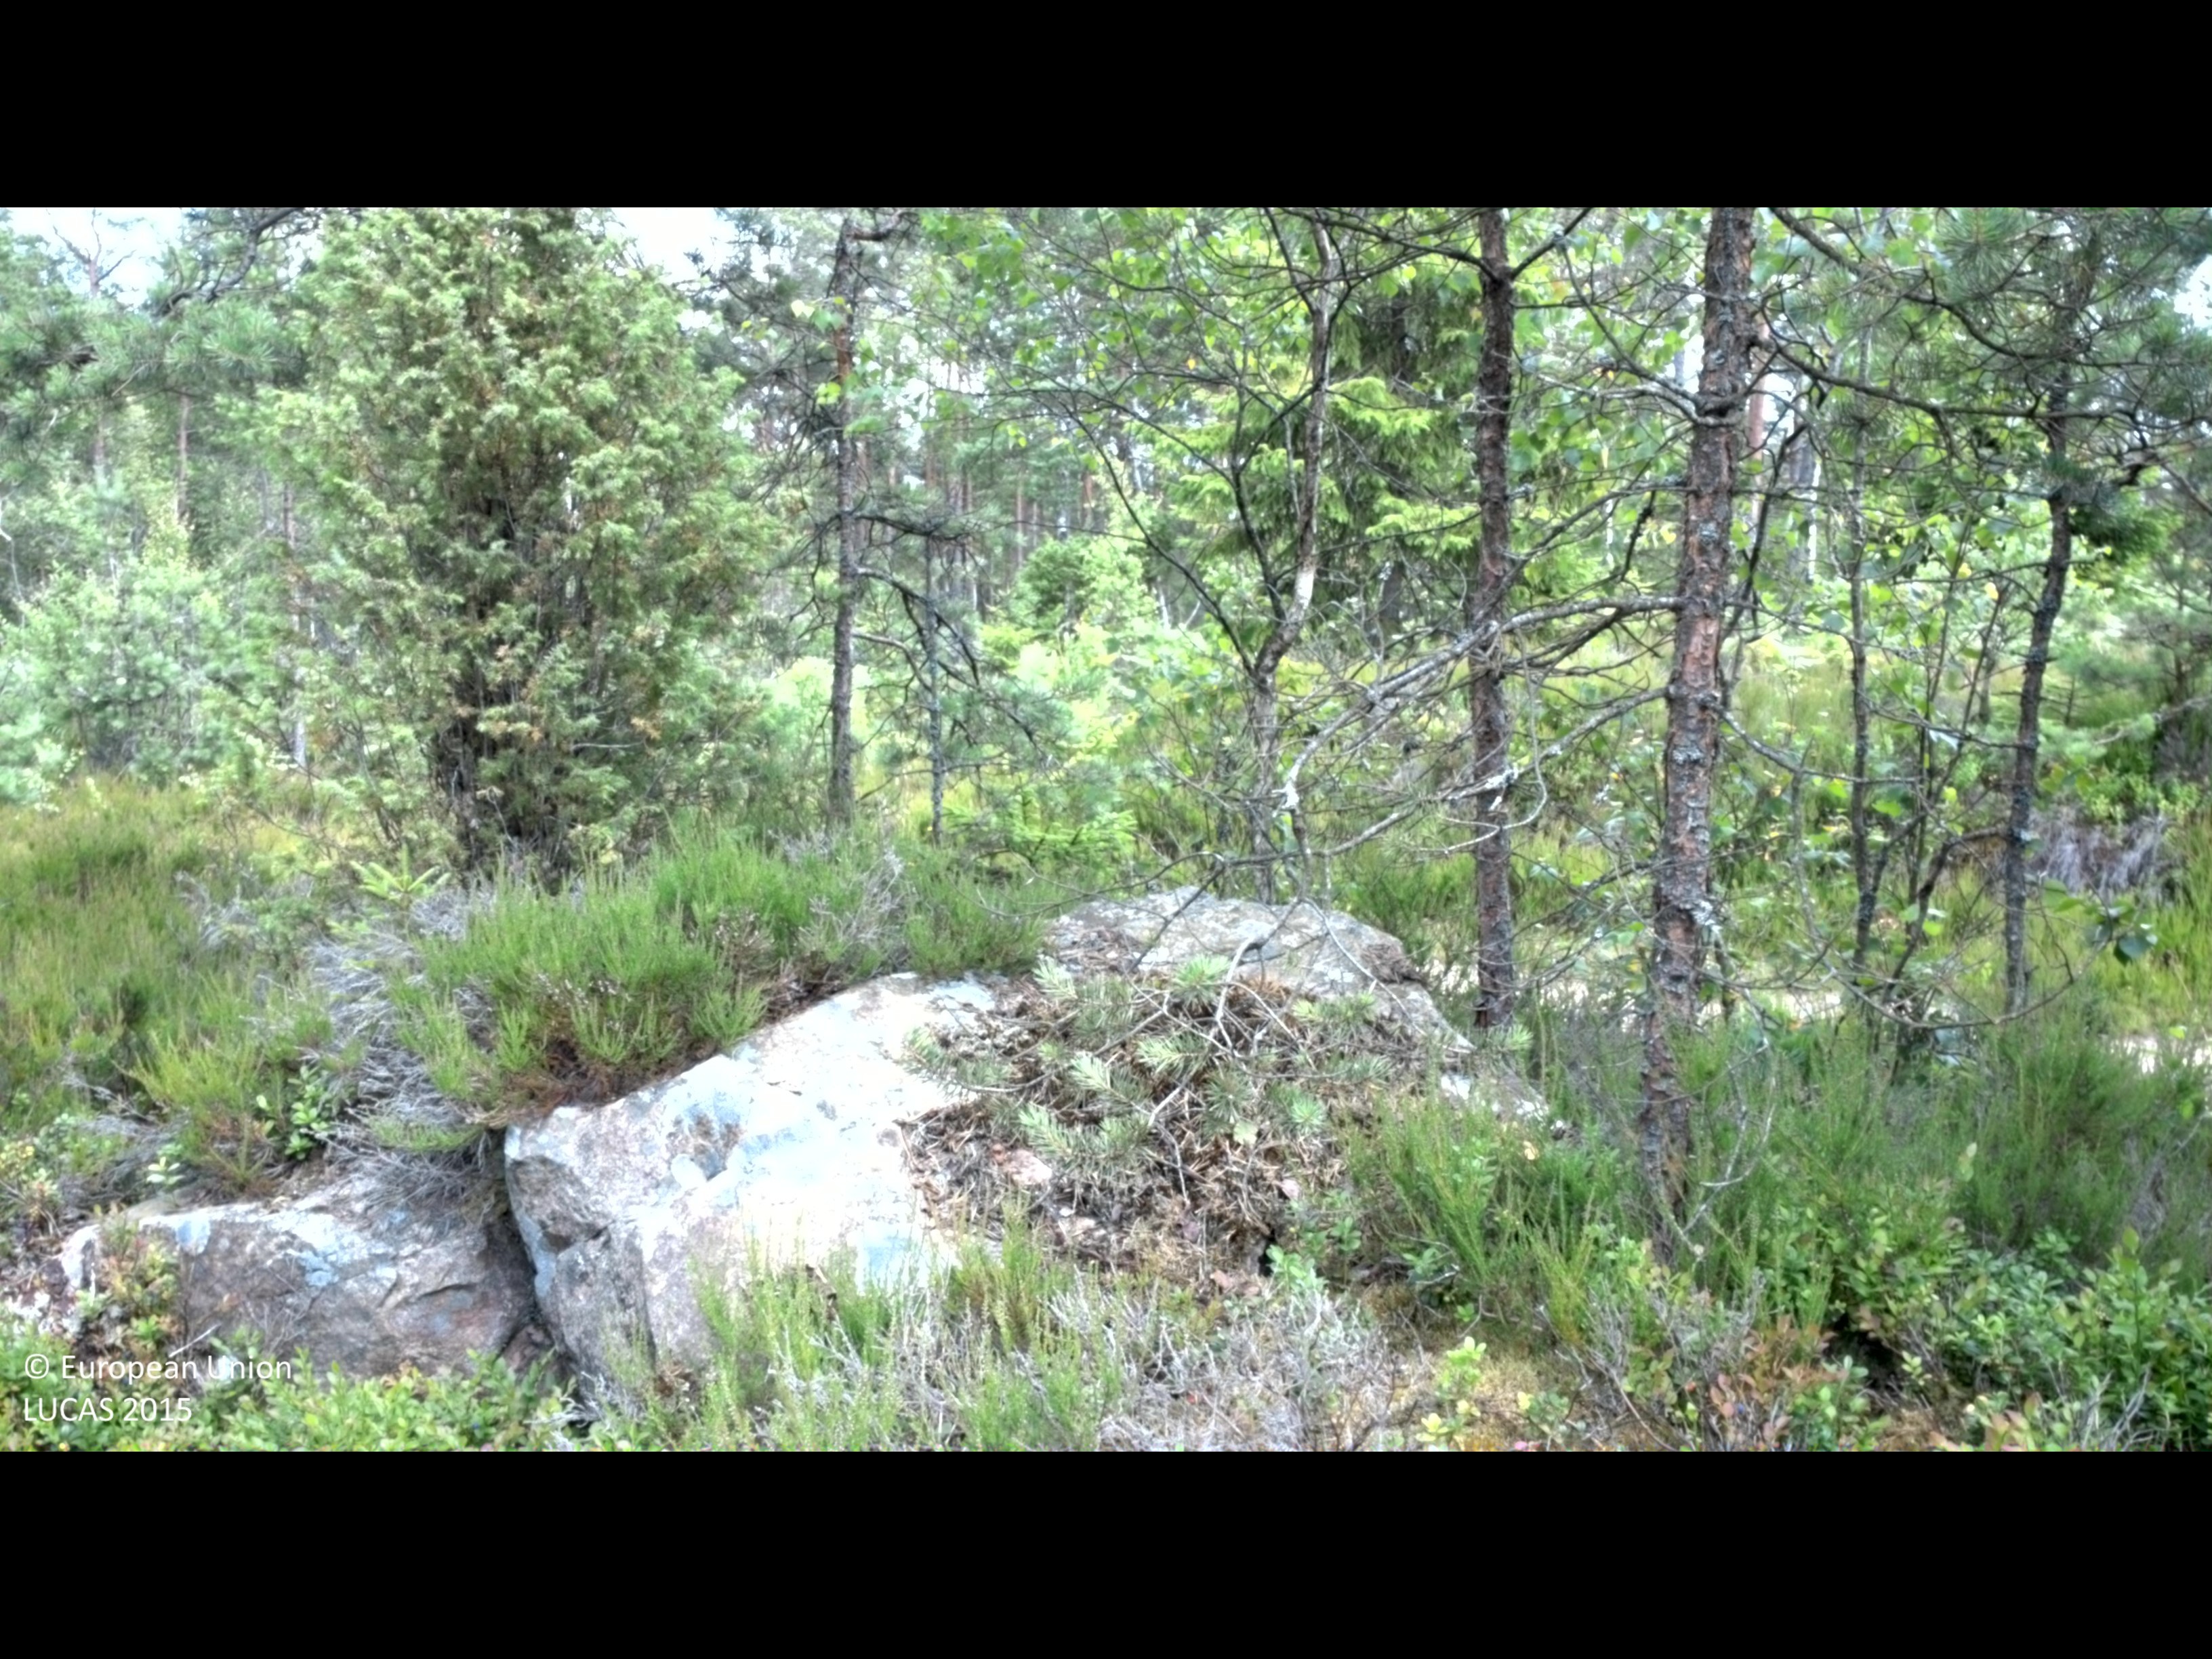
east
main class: Woodland
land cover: Pine dominated mixed woodland
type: boreal forest
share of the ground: 25 - 50 %
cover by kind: shrubs 35 %, coniferous forest trees 30 %, broadleaved forest trees 20 %, herbaceous plants 15 %
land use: Forestry
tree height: > 5 m
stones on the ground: 25 - 50 %
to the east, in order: Pine dominated mixed woodland; Shruby margins; Tracks; Shruby margins; Spruce dominated mixed woodland; Pine dominated mixed woodland; Pine dominated coniferous woodland
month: July
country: SE
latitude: 56.5289
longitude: 13.7525
